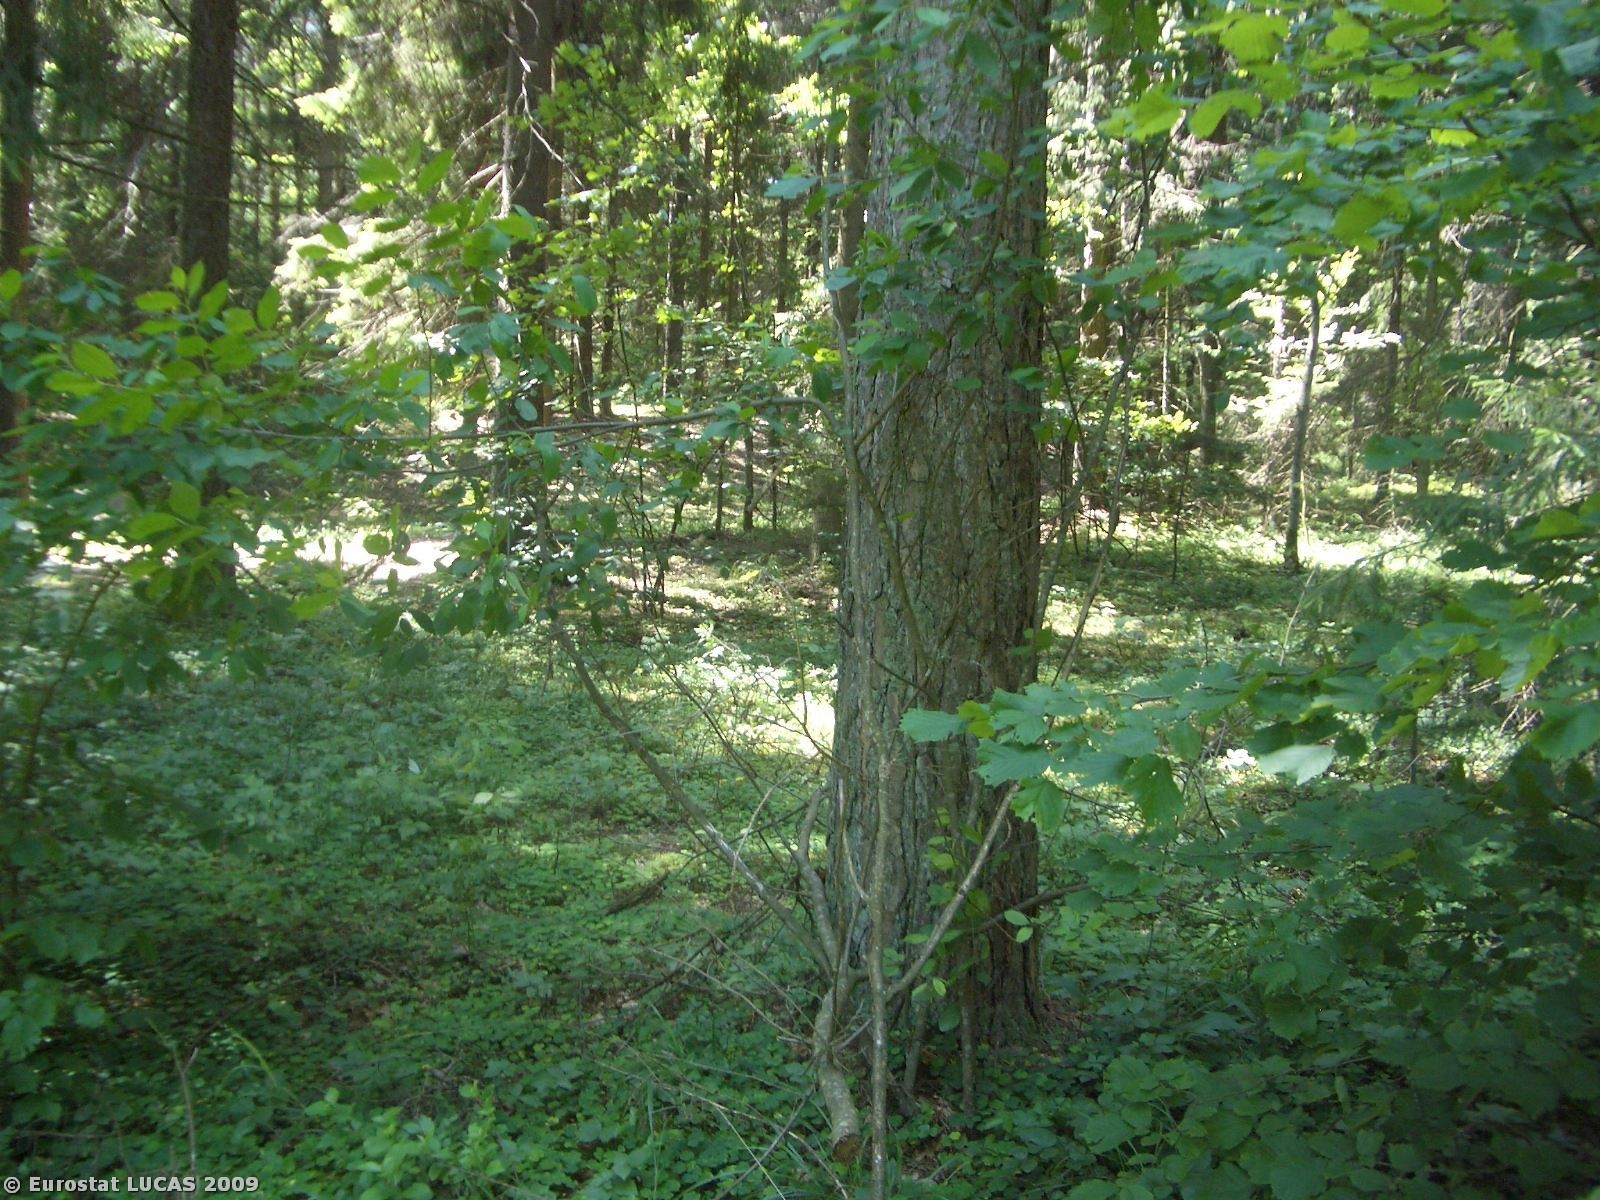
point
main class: Woodland
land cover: Mixed woodland
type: hemiboreal forest and nemoral coniferous forest and mixed broadleaved-coniferous forest
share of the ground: > 75 %
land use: Forestry
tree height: > 5 m
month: July
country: PL
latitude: 54.0124
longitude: 23.3098
